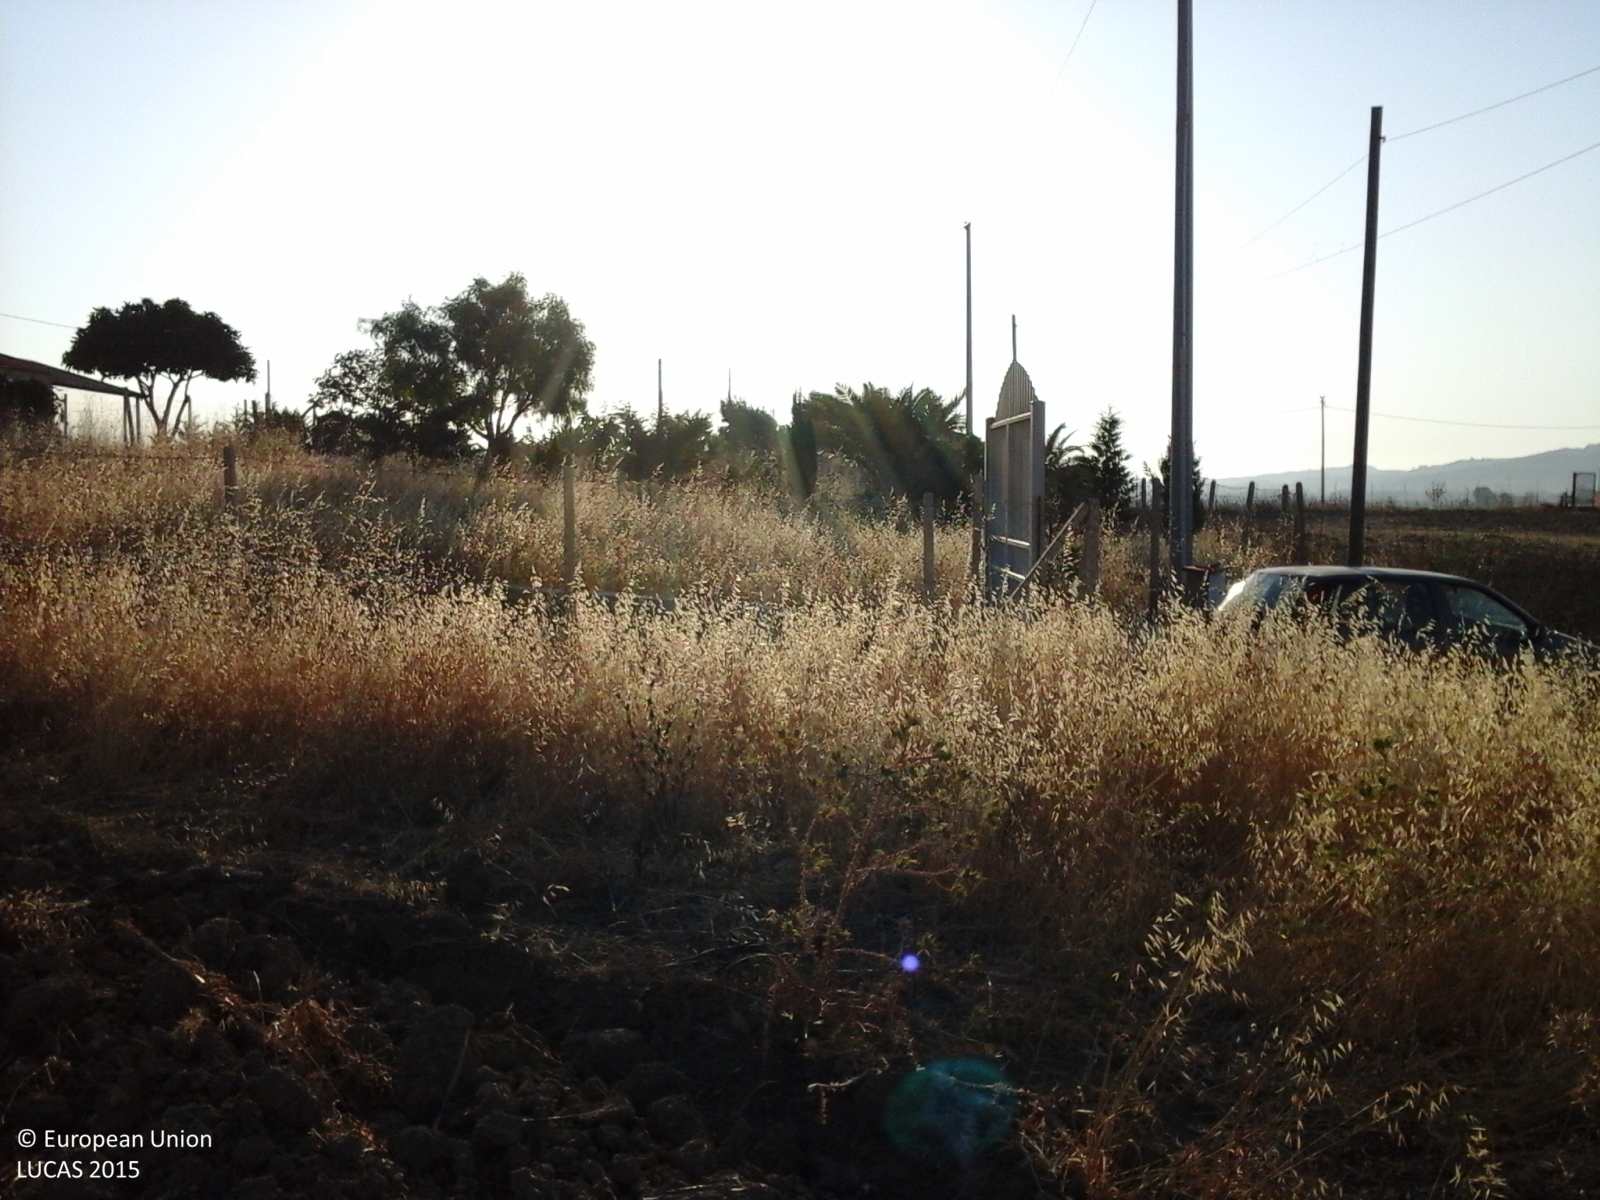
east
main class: Cropland
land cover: Other leguminous and mixtures for fodder
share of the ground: > 75 %
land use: Agriculture (excluding fallow land and kitchen gardens)
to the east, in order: Other leguminous and mixtures for fodder; Fences; Spontaneously vegetated surfaces; Fences; Paved roads, cycling and walking lanes; Fences; Electric lines; Paved roads, cycling and walking lanes; Fences; Durum wheat; Fences; Paved roads, cycling and walking lanes; Durum wheat; Electric lines; Durum wheat
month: July
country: IT
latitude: 37.1138
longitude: 14.0978
